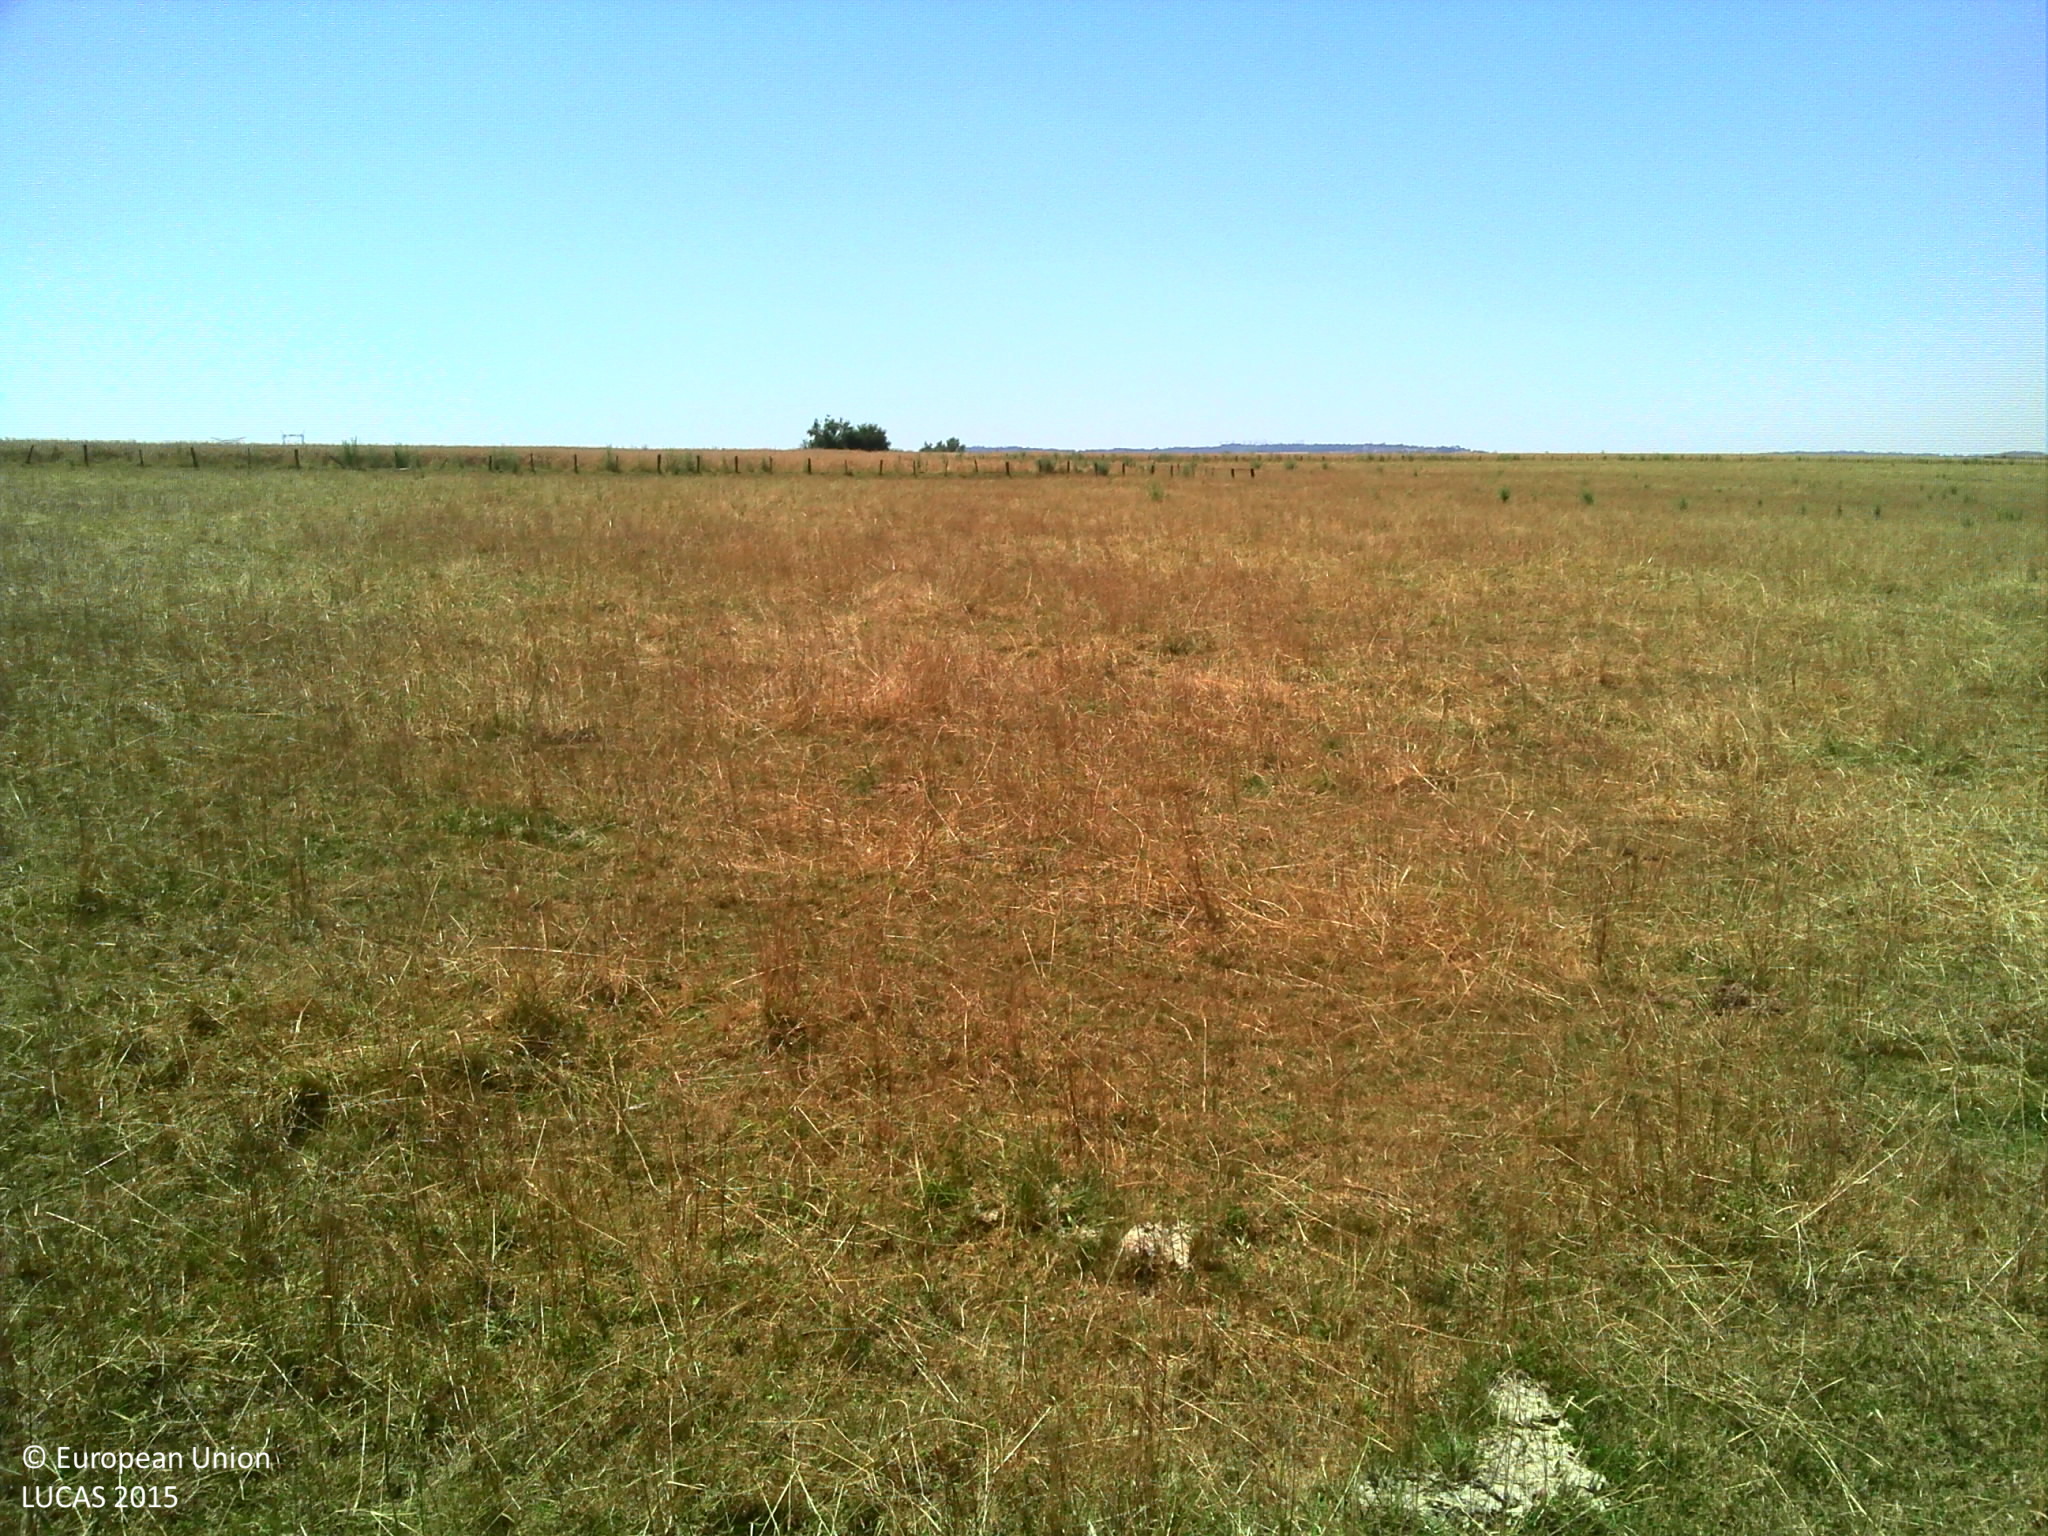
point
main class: Grassland
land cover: Grassland without tree/shrub cover
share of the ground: > 75 %
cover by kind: herbaceous plants 100 %
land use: Agriculture (excluding fallow land and kitchen gardens)
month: July
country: FR
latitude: 48.9323
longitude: 6.1914
